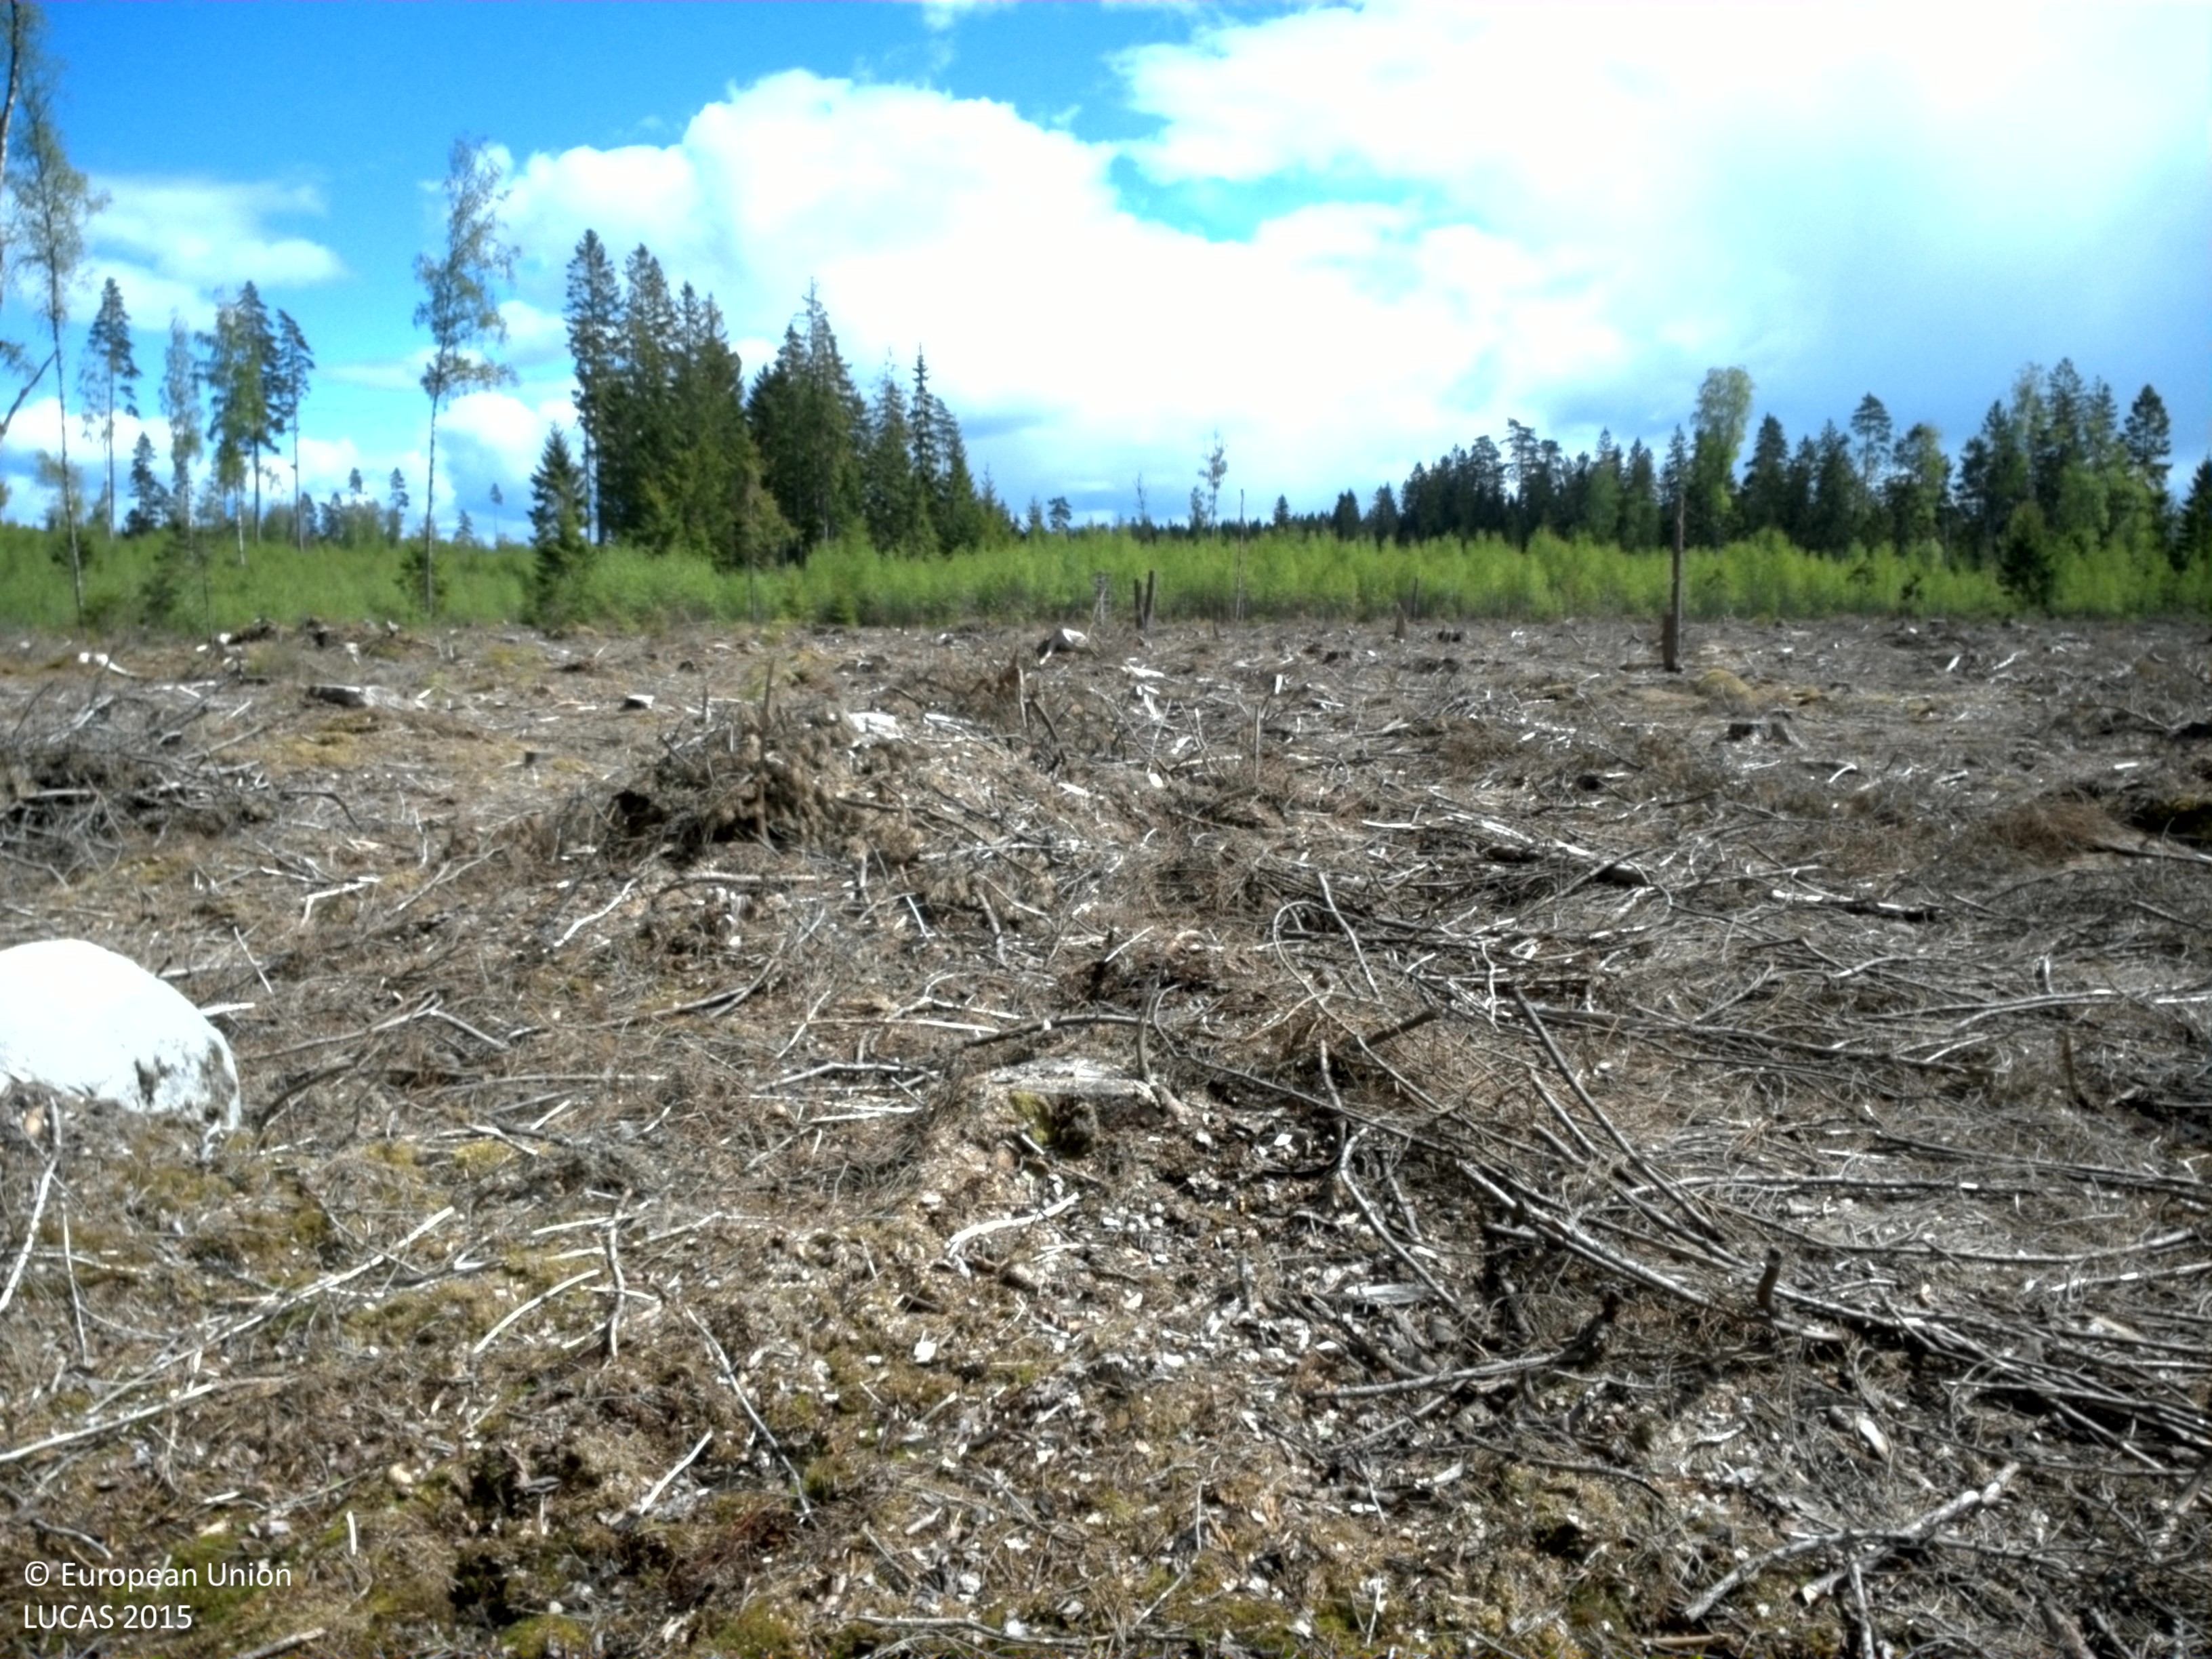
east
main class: Shrubland
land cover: Shrubland with sparse tree cover
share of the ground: 10 - 25 %
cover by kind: herbaceous plants 25 %, lichens and mosses 20 %, shrubs 10 %, coniferous forest trees 5 %
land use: Forestry
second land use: Amenities, museums, leisure
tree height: < 5 m
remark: Clear cut
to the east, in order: Shrubland with sparse tree cover; Tracks; Broadleaved woodland; Pine dominated mixed woodland
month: May
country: SE
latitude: 56.9466
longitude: 14.7478
